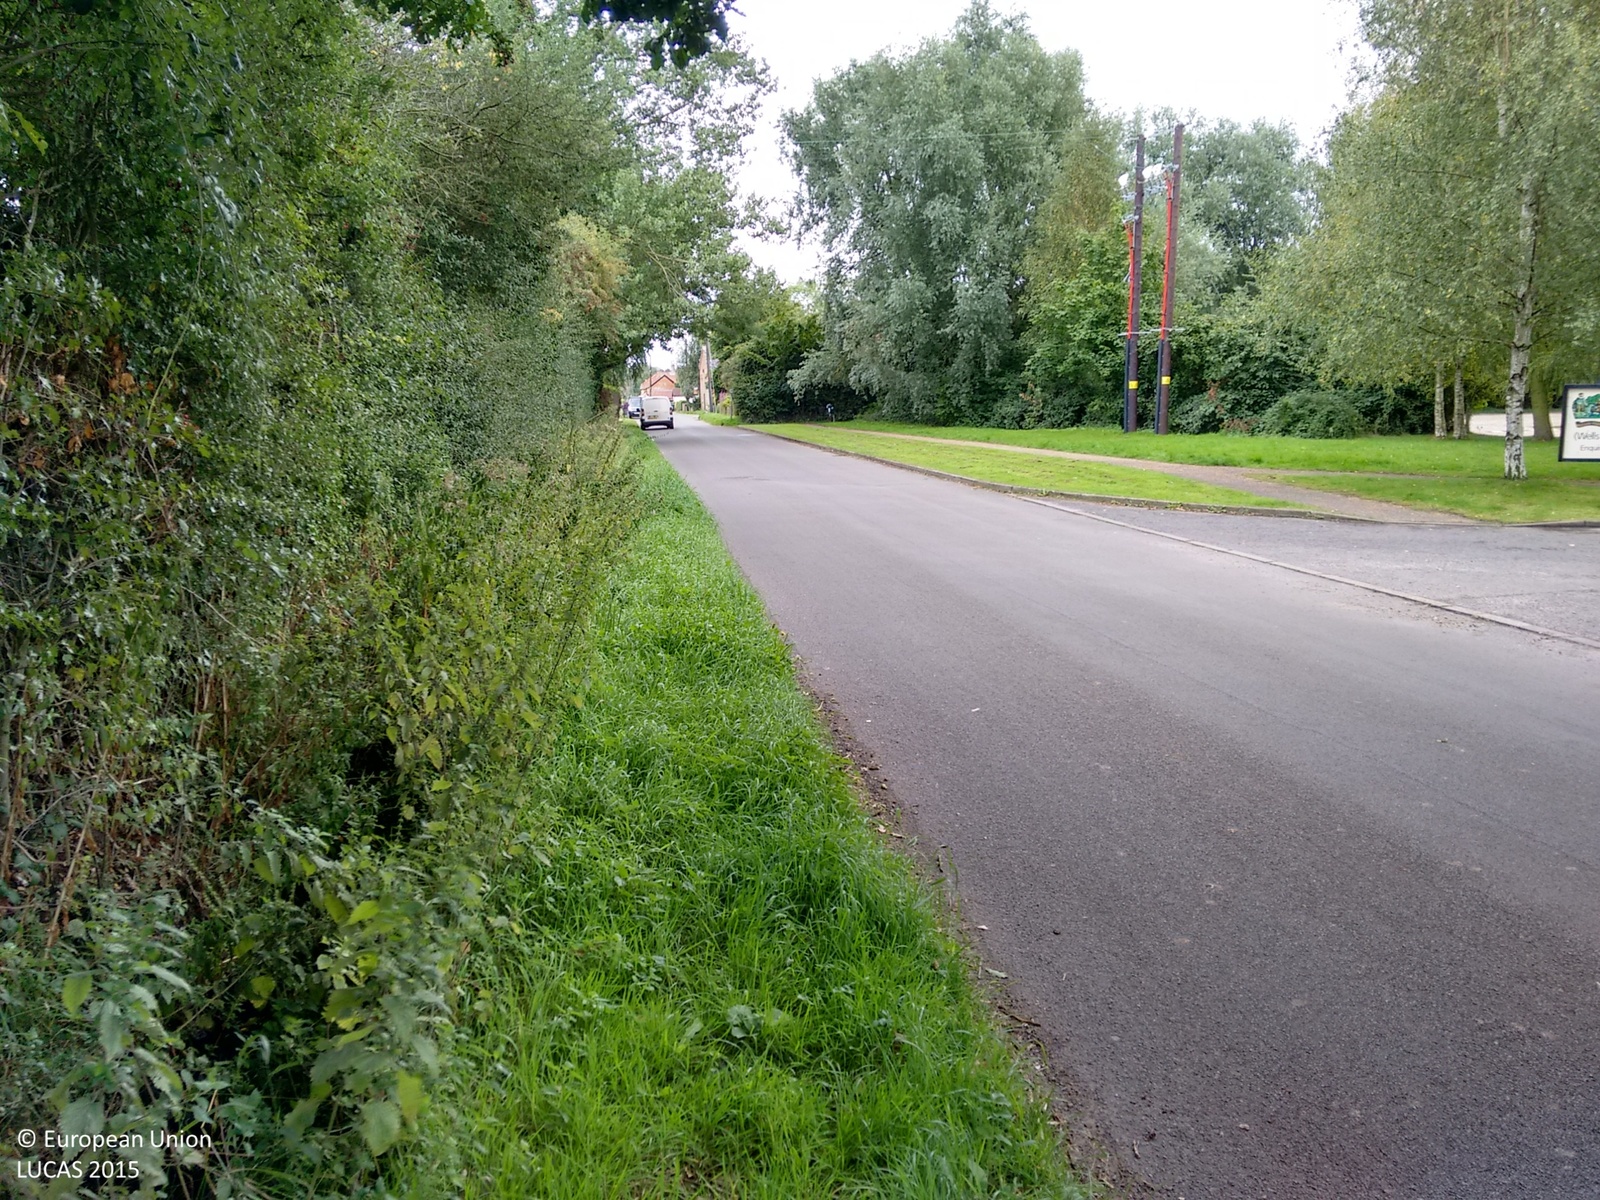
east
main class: Grassland
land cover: Grassland without tree/shrub cover
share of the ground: > 75 %
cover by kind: herbaceous plants 100 %
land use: Residential
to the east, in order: Grassland without tree/shrub cover; Electric lines; Grassland without tree/shrub cover; Fences; Managed hedges; Ditches and canals; Grass margins; Artificial constructions in urban areas
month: September
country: GB
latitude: 52.5814
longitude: 0.8106
